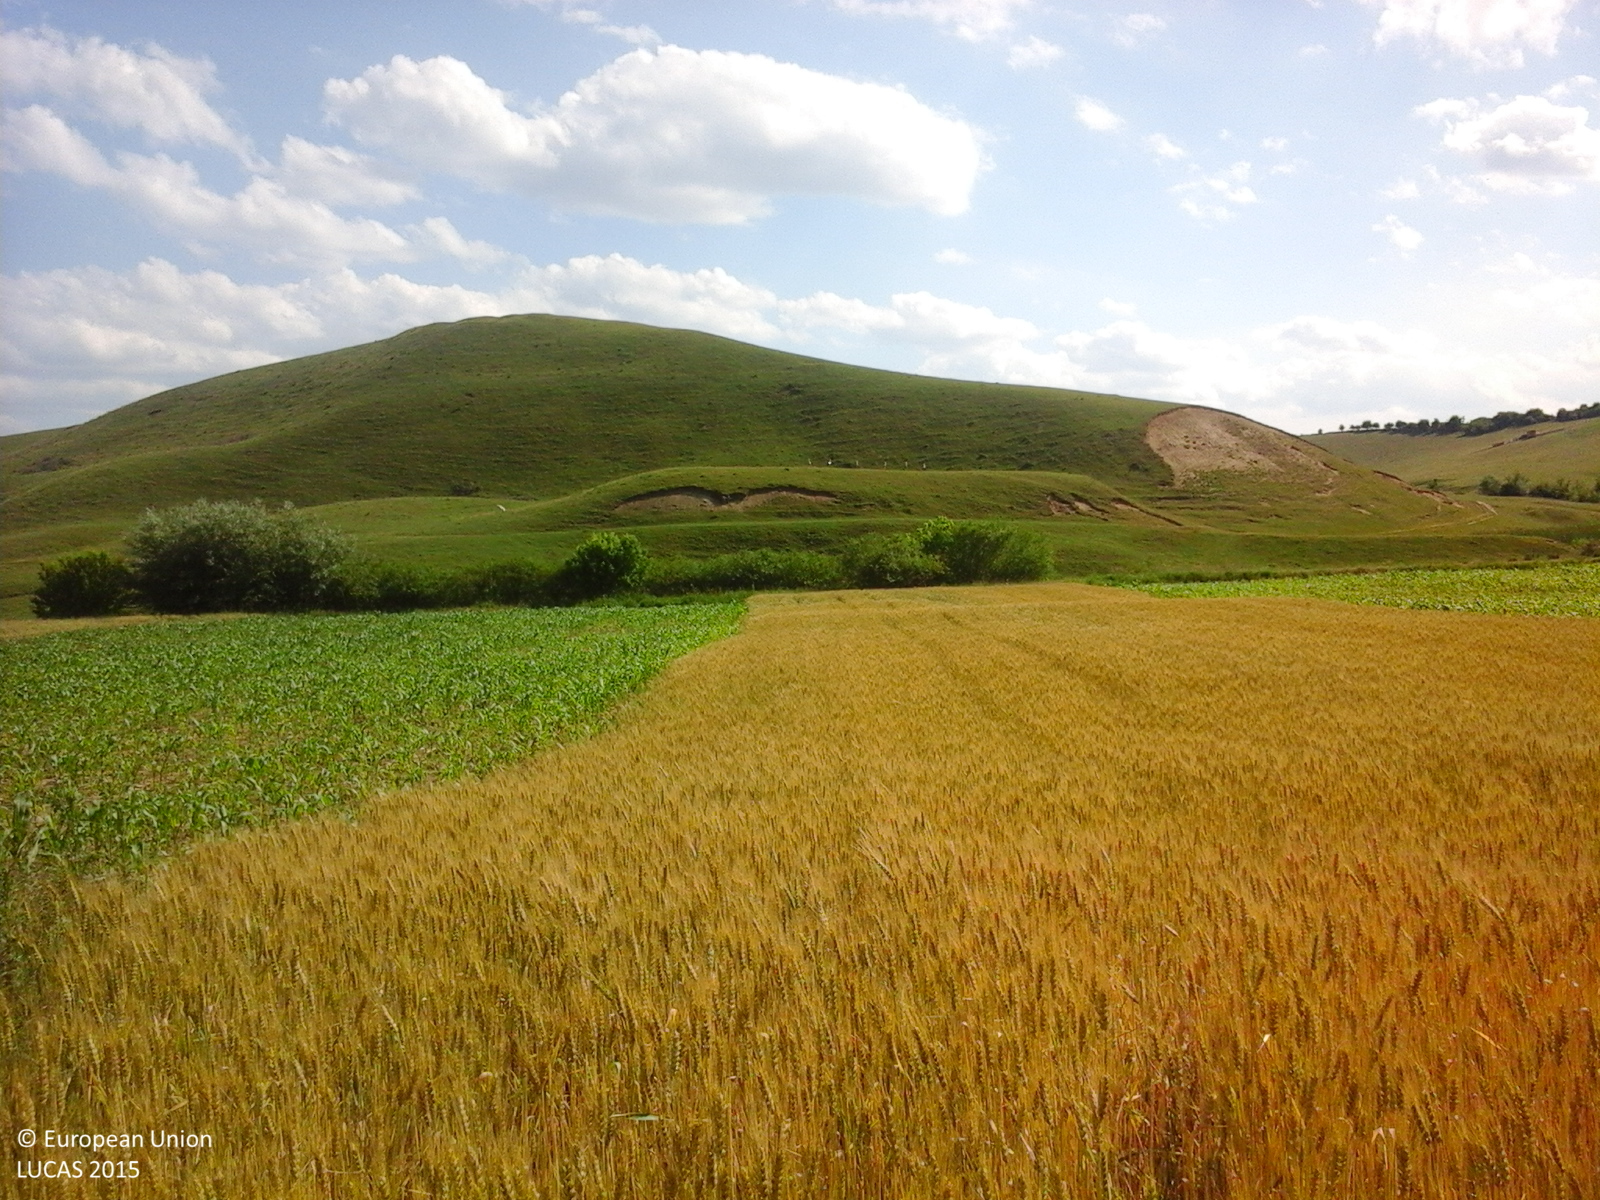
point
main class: Cropland
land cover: Common wheat
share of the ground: > 75 %
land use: Agriculture (excluding fallow land and kitchen gardens)
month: June
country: RO
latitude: 47.9282
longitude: 26.3491
